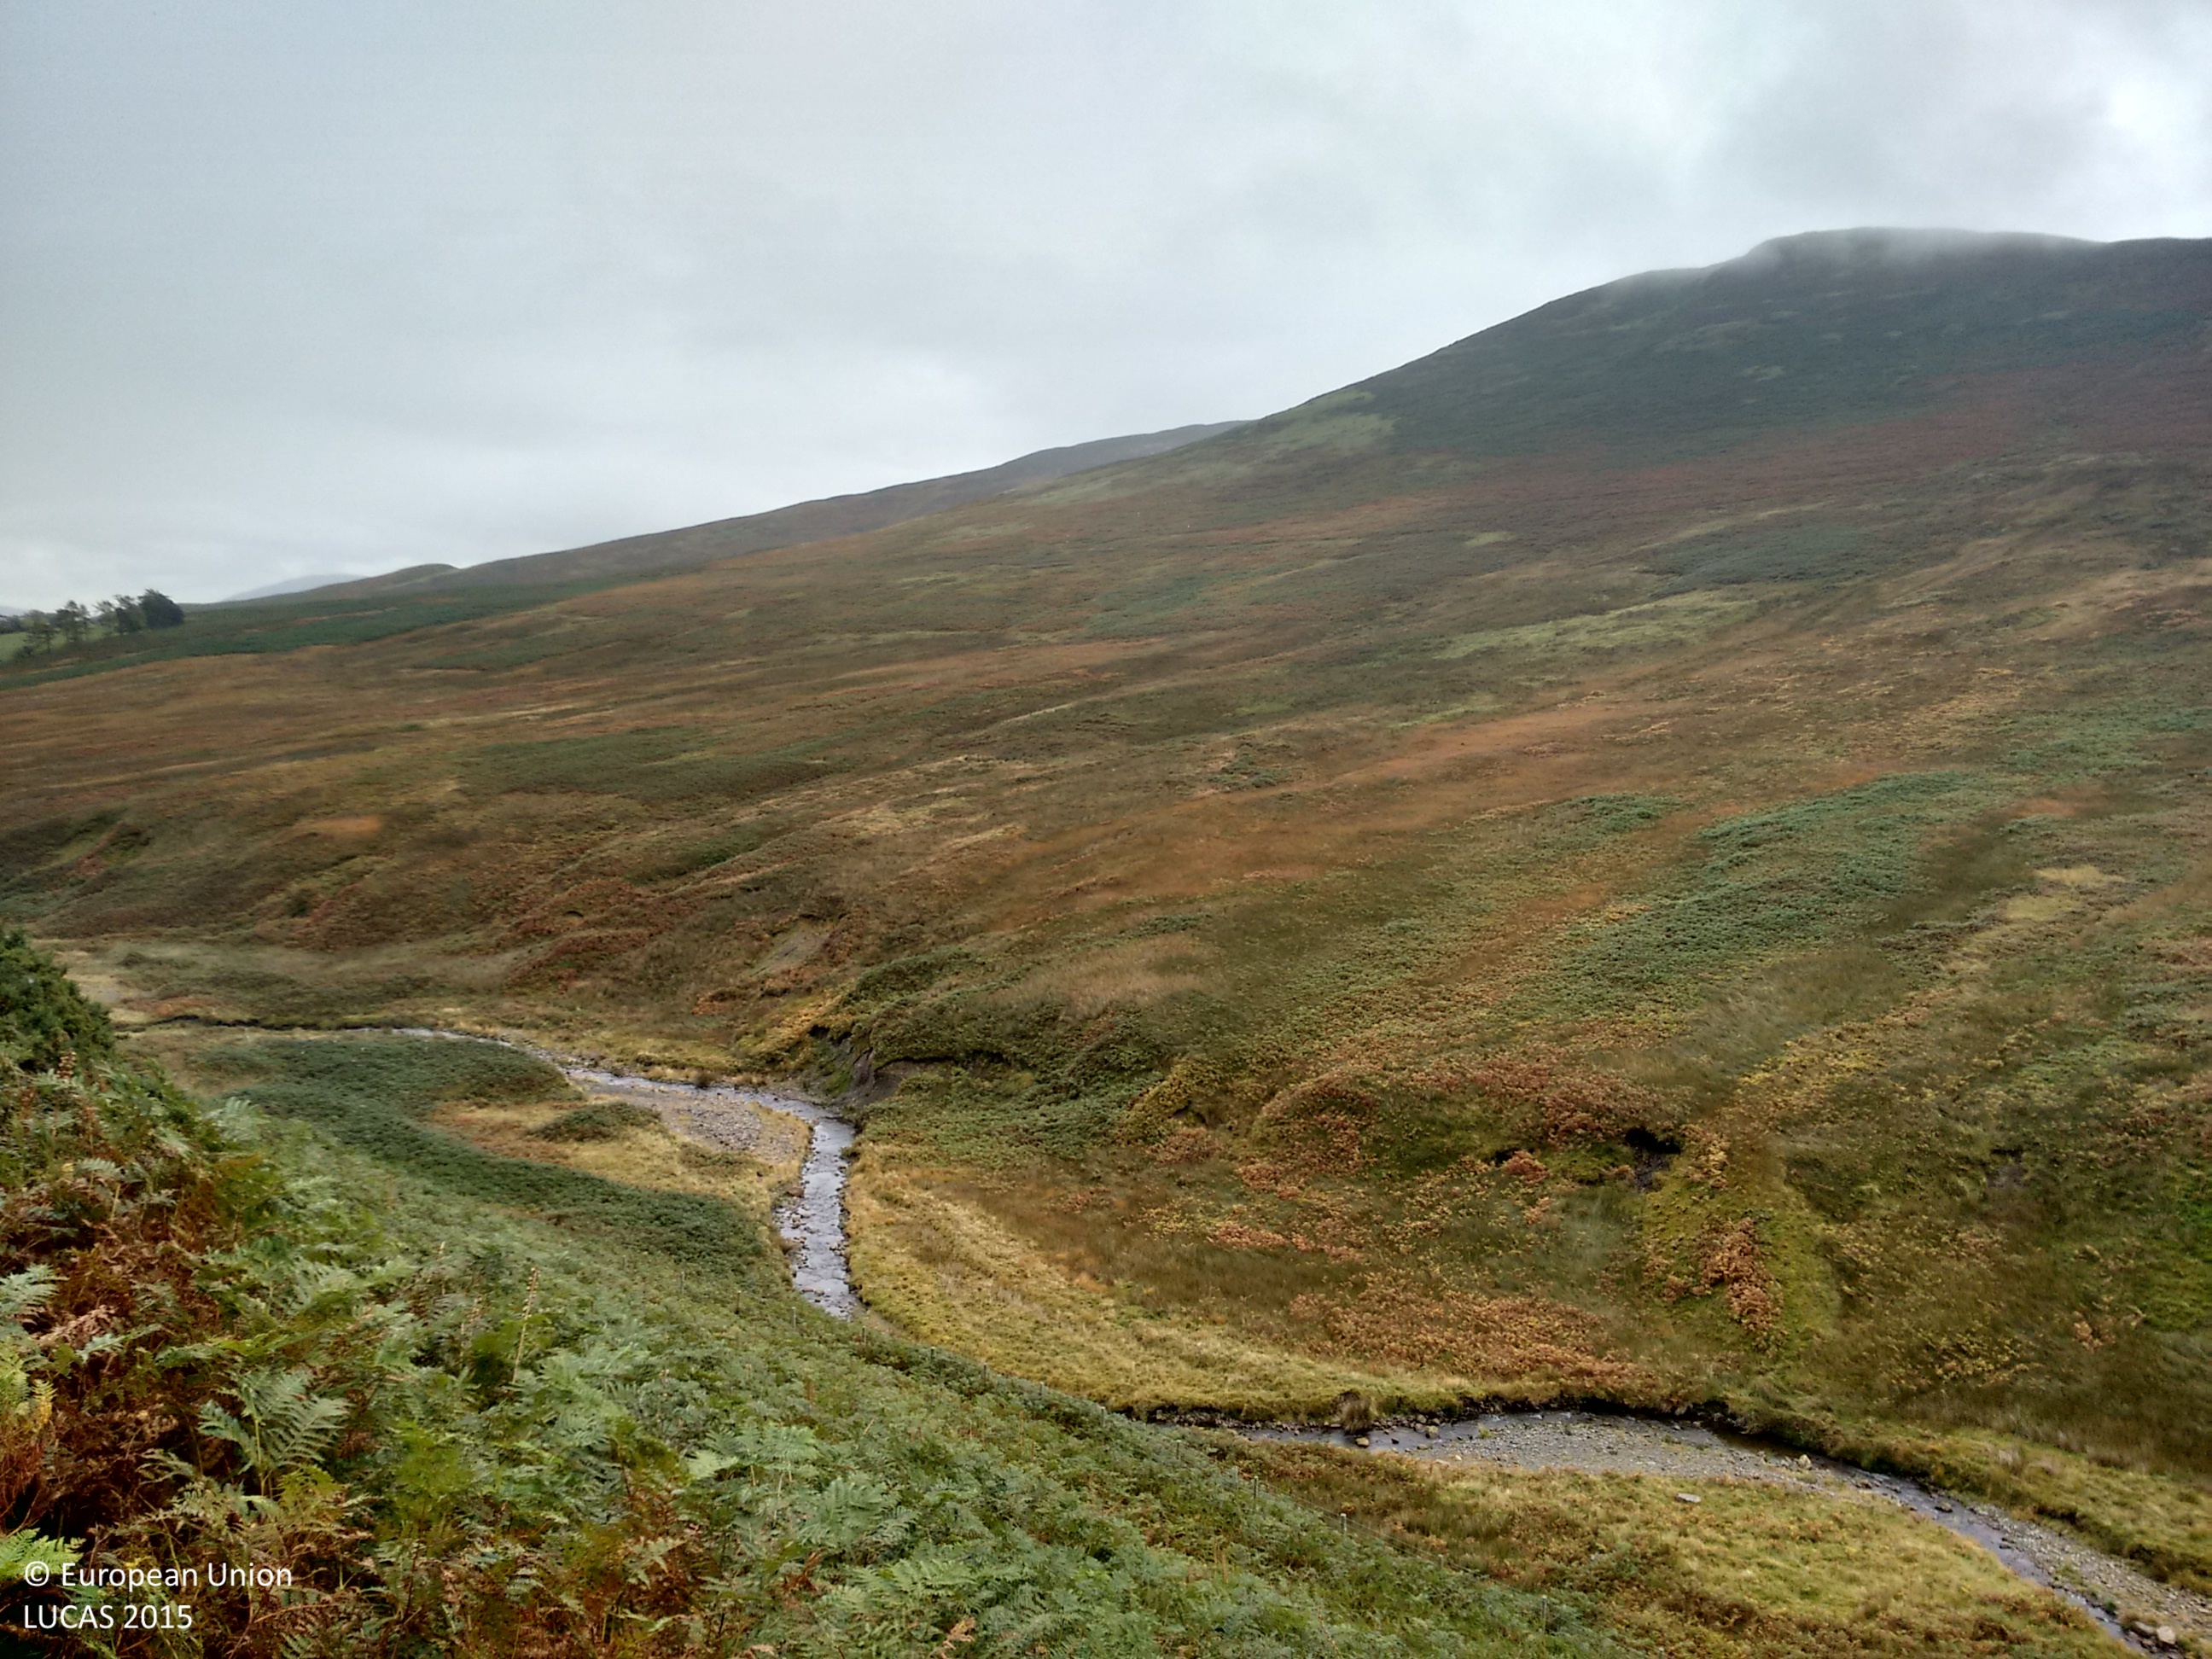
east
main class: Shrubland
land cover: Shrubland without tree cover
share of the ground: > 75 %
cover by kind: shrubs 100 %
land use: Agriculture (excluding fallow land and kitchen gardens)
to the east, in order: Shrubland without tree cover; Tracks; Shrubland without tree cover; Ditches and canals; Shrubland without tree cover
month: October
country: GB
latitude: 54.5882
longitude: -3.2143
